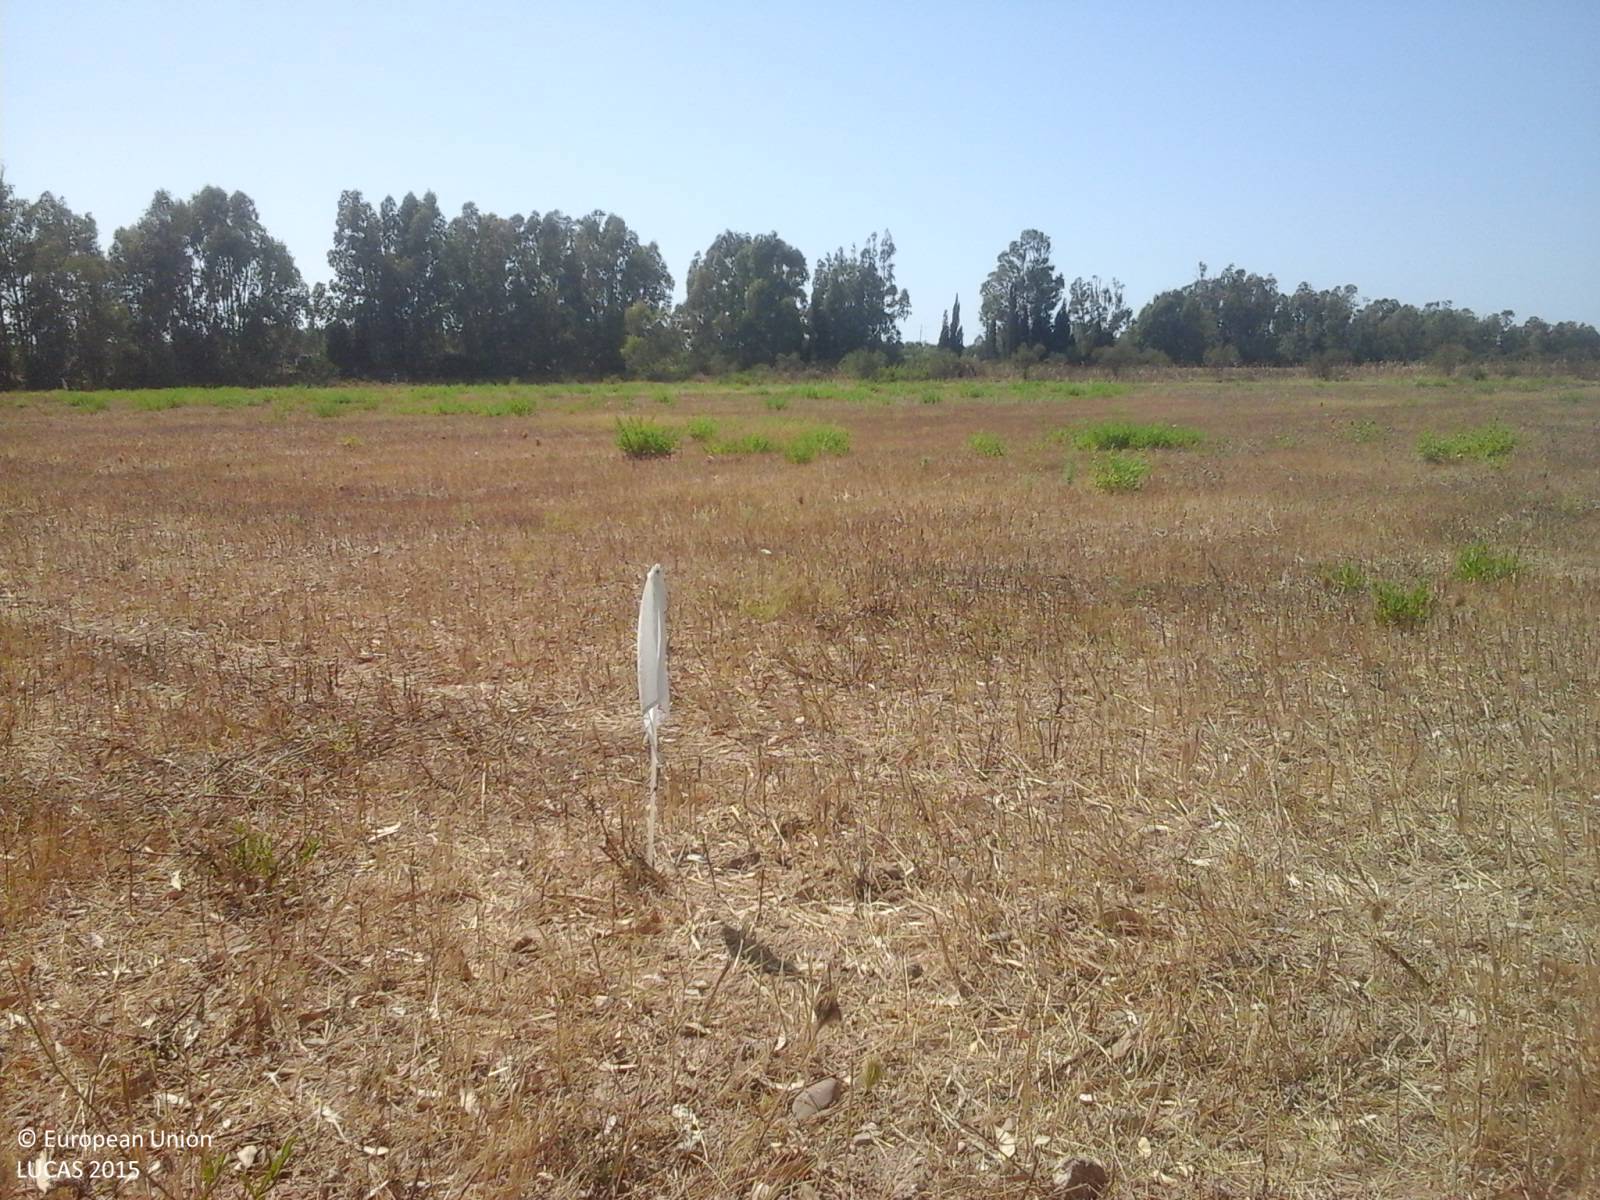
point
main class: Cropland
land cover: Durum wheat
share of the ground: > 75 %
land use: Agriculture (excluding fallow land and kitchen gardens)
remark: Harvested field
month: July
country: IT
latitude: 39.0789
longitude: 8.5412
